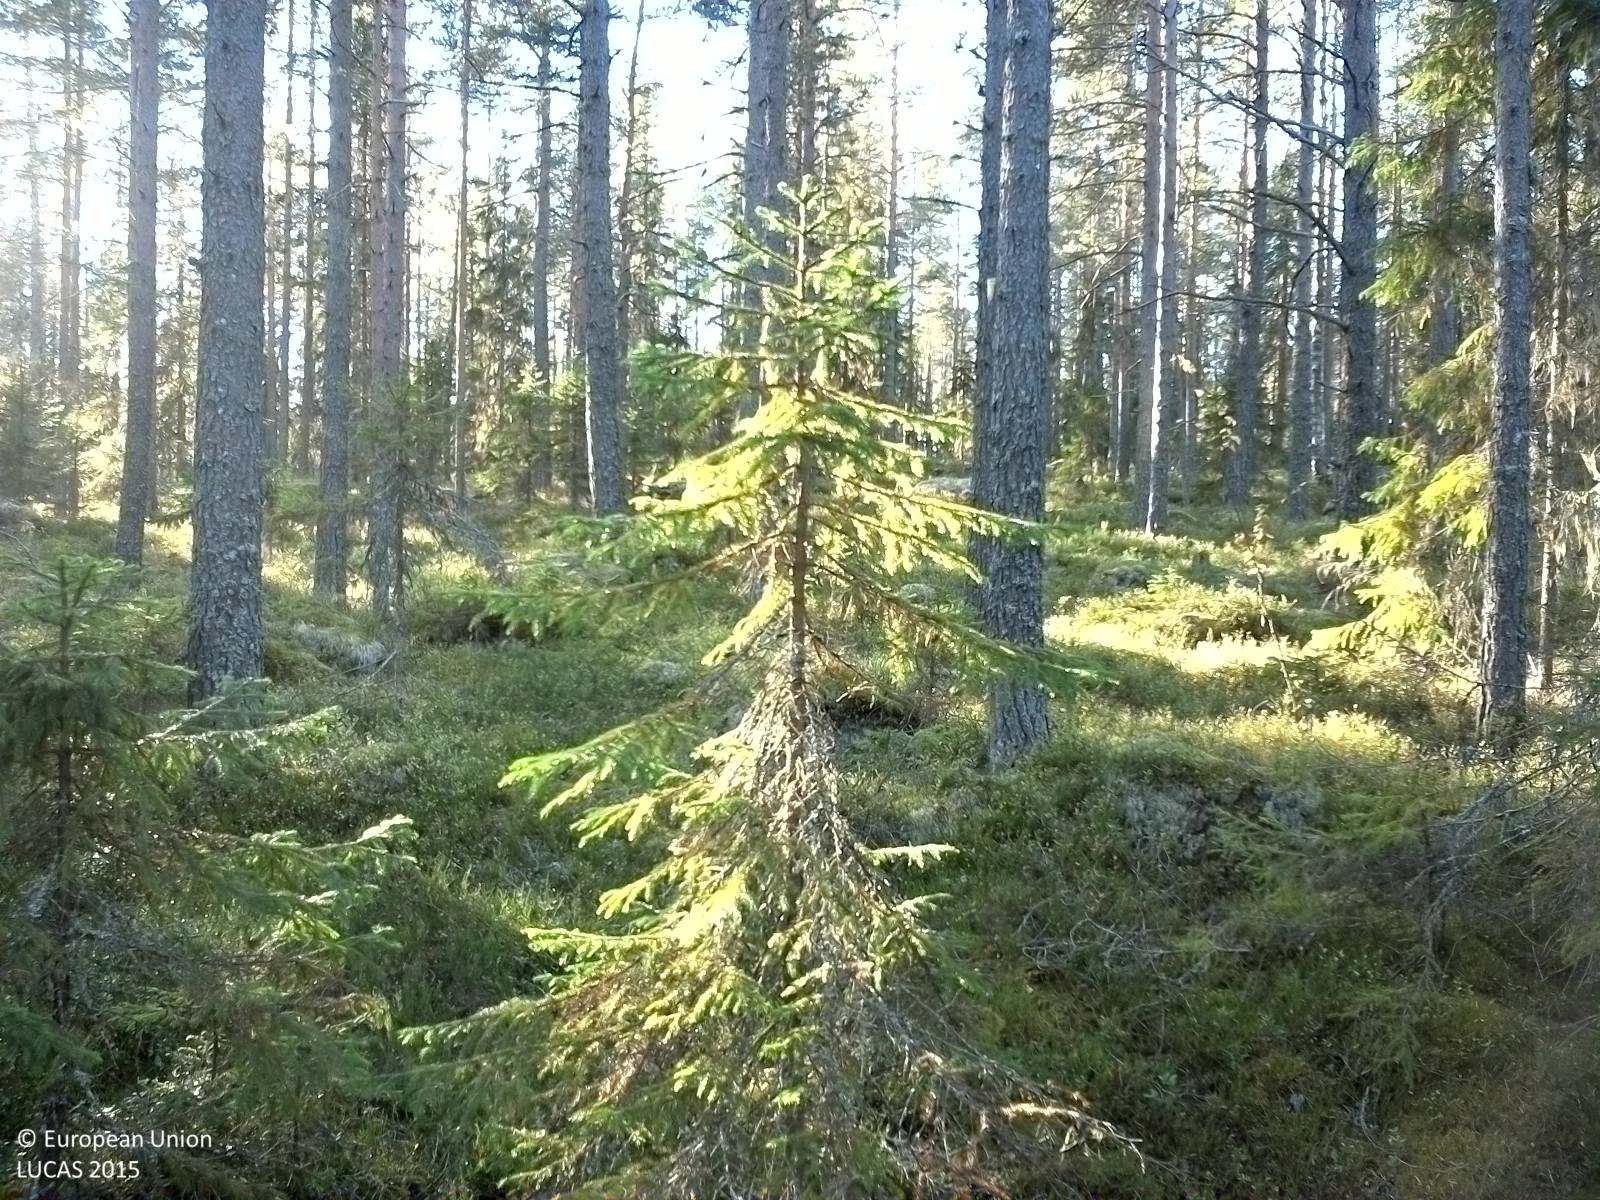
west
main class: Woodland
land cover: Pine dominated coniferous woodland
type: boreal forest
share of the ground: > 75 %
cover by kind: coniferous forest trees 75 %, shrubs 15 %, lichens and mosses 10 %
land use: Forestry
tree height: > 5 m
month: September
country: SE
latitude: 62.2570
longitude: 17.2407
